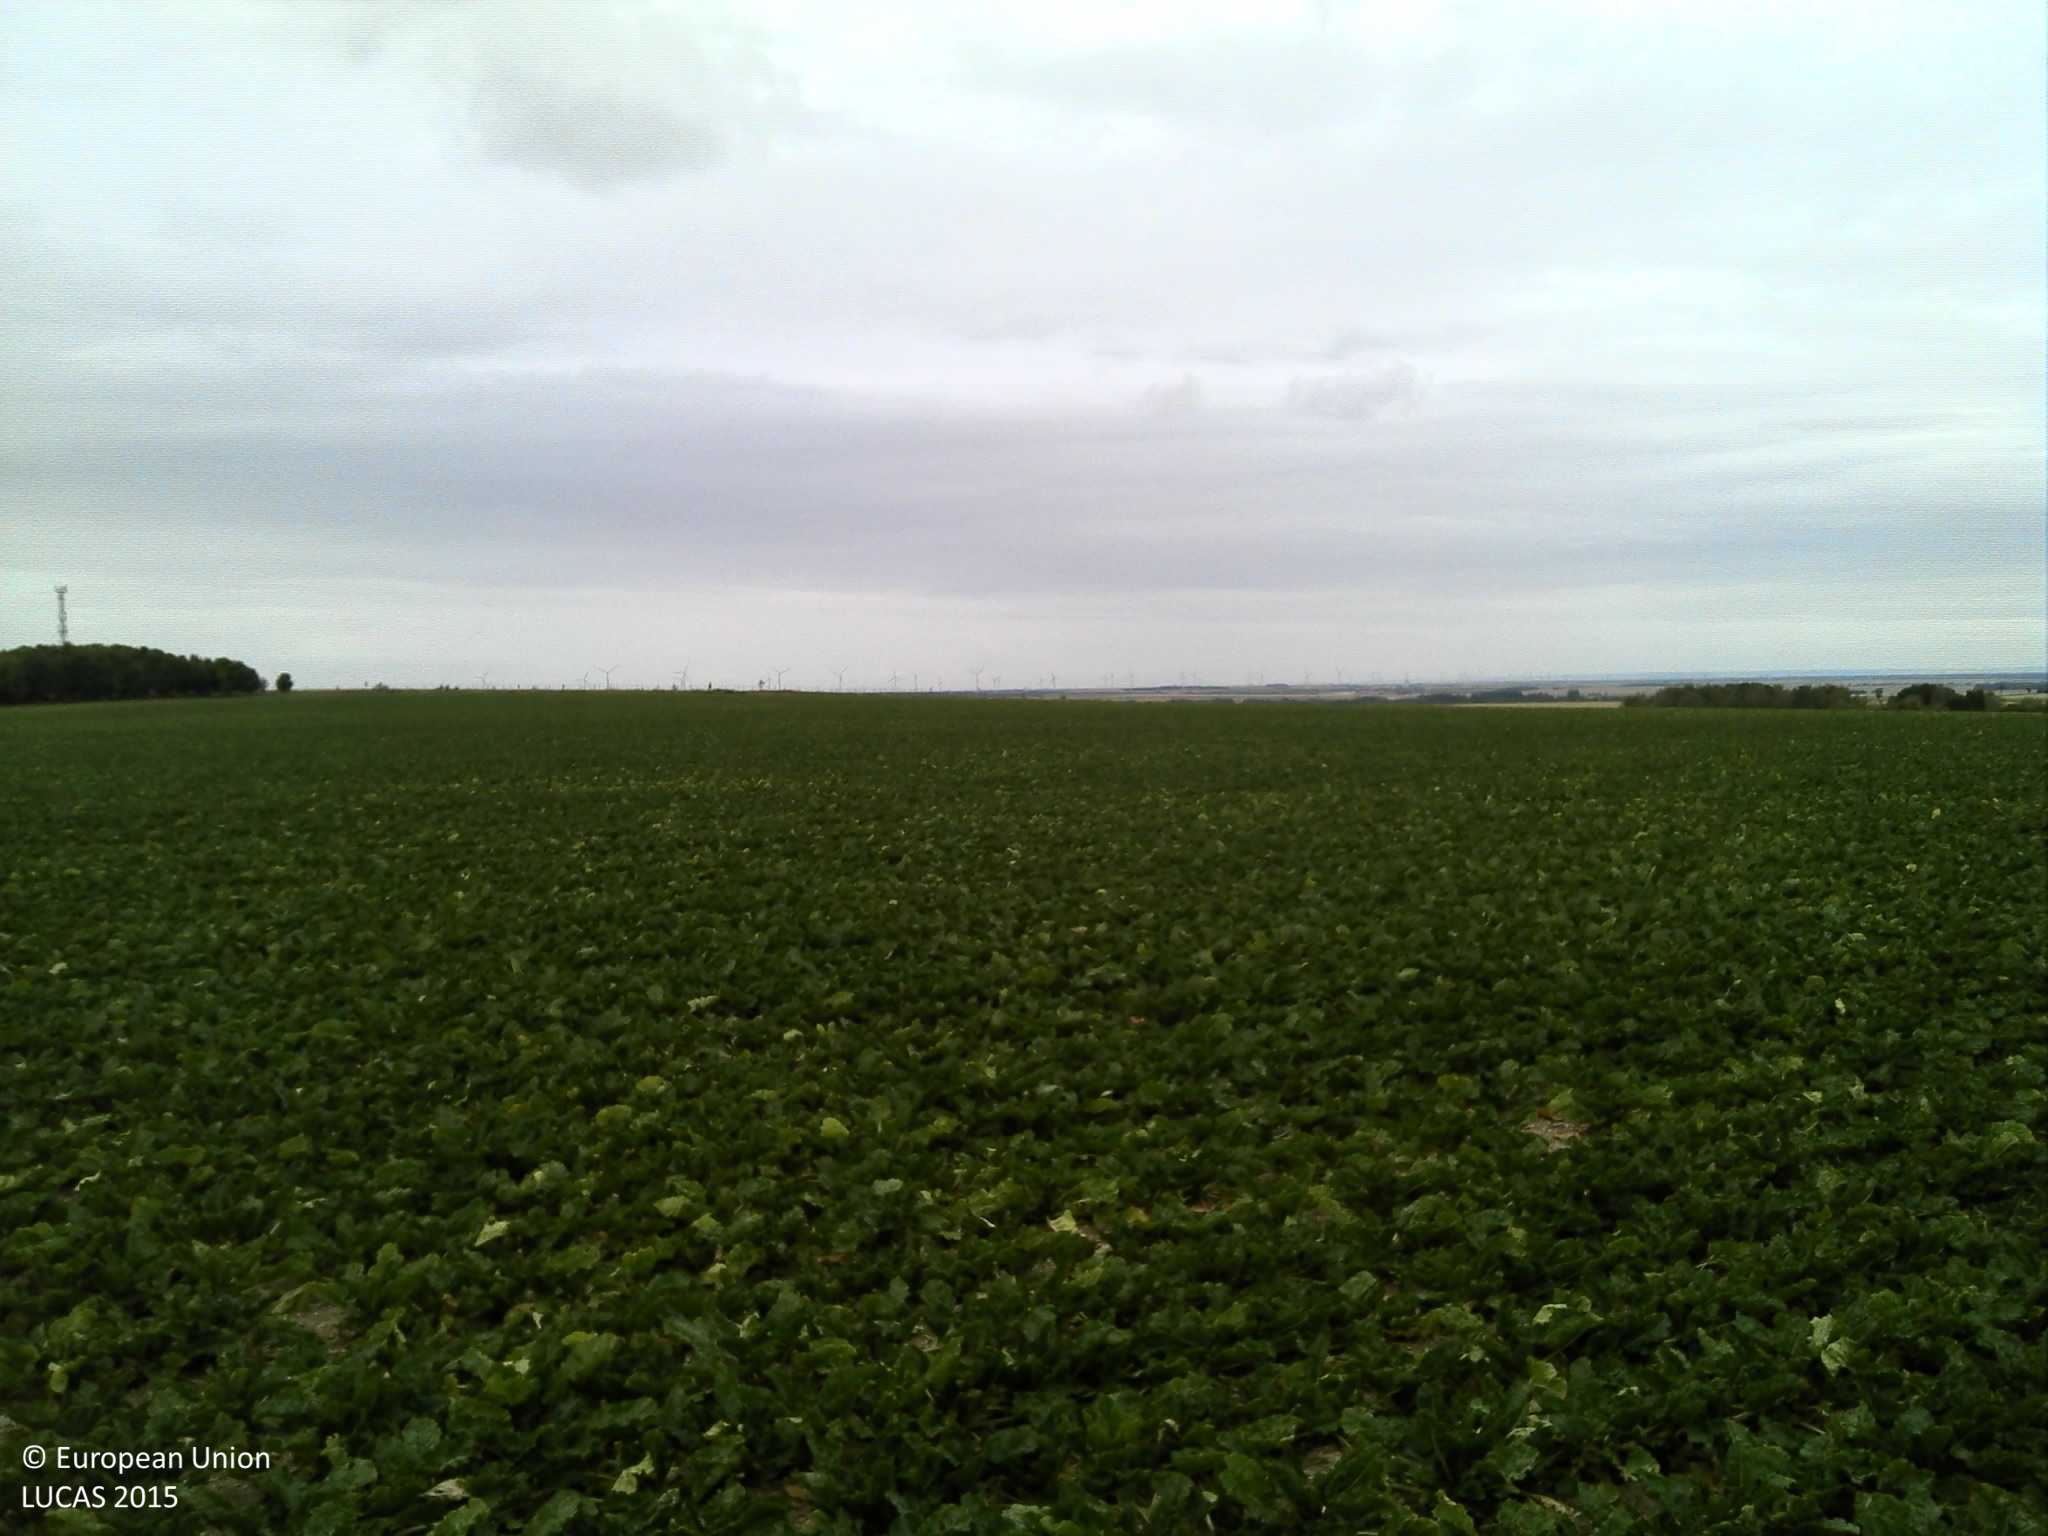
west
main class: Cropland
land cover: Sugar beet
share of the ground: > 75 %
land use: Agriculture (excluding fallow land and kitchen gardens)
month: August
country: FR
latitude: 48.4660
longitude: 4.1672
